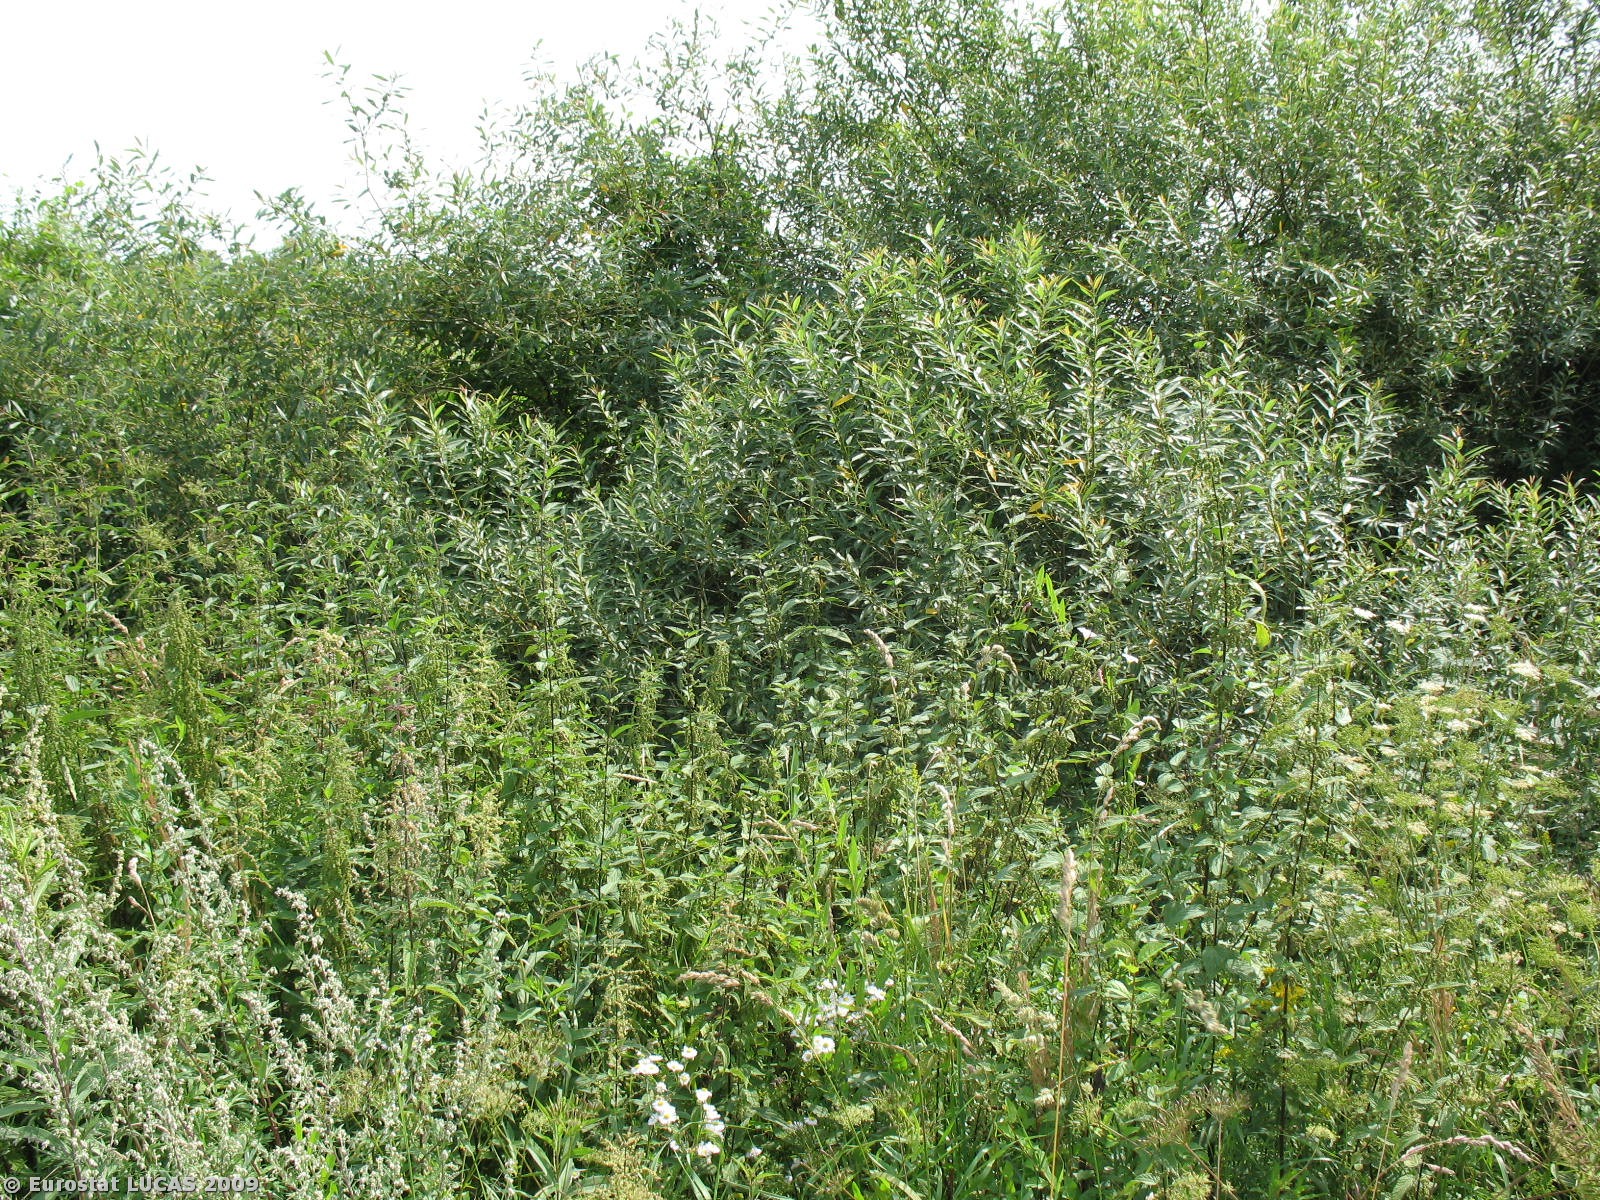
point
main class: Shrubland
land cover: Shrubland with sparse tree cover
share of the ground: > 75 %
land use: Nature reserves
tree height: > 5 m
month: August
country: PL
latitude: 49.7615
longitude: 22.3765
